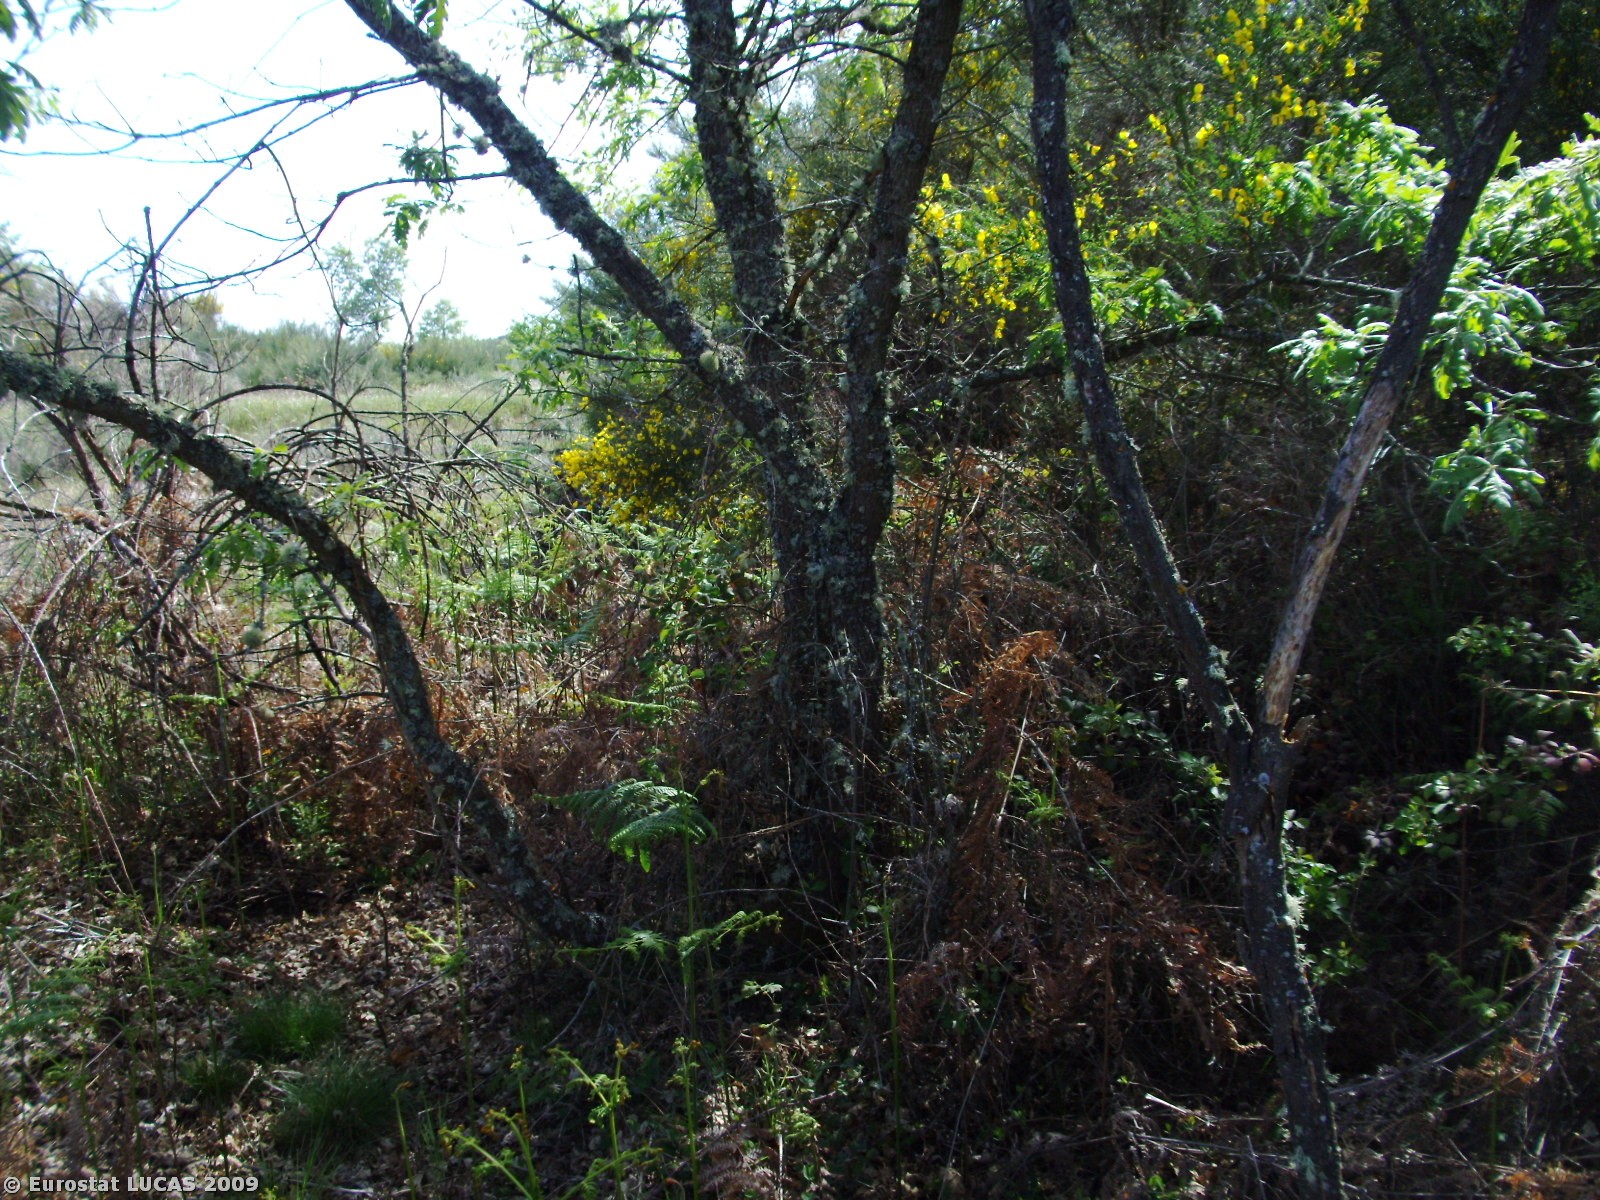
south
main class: Woodland
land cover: Broadleaved woodland
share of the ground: > 75 %
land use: Forestry
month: May
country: PT
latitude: 40.9756
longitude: -7.3591
